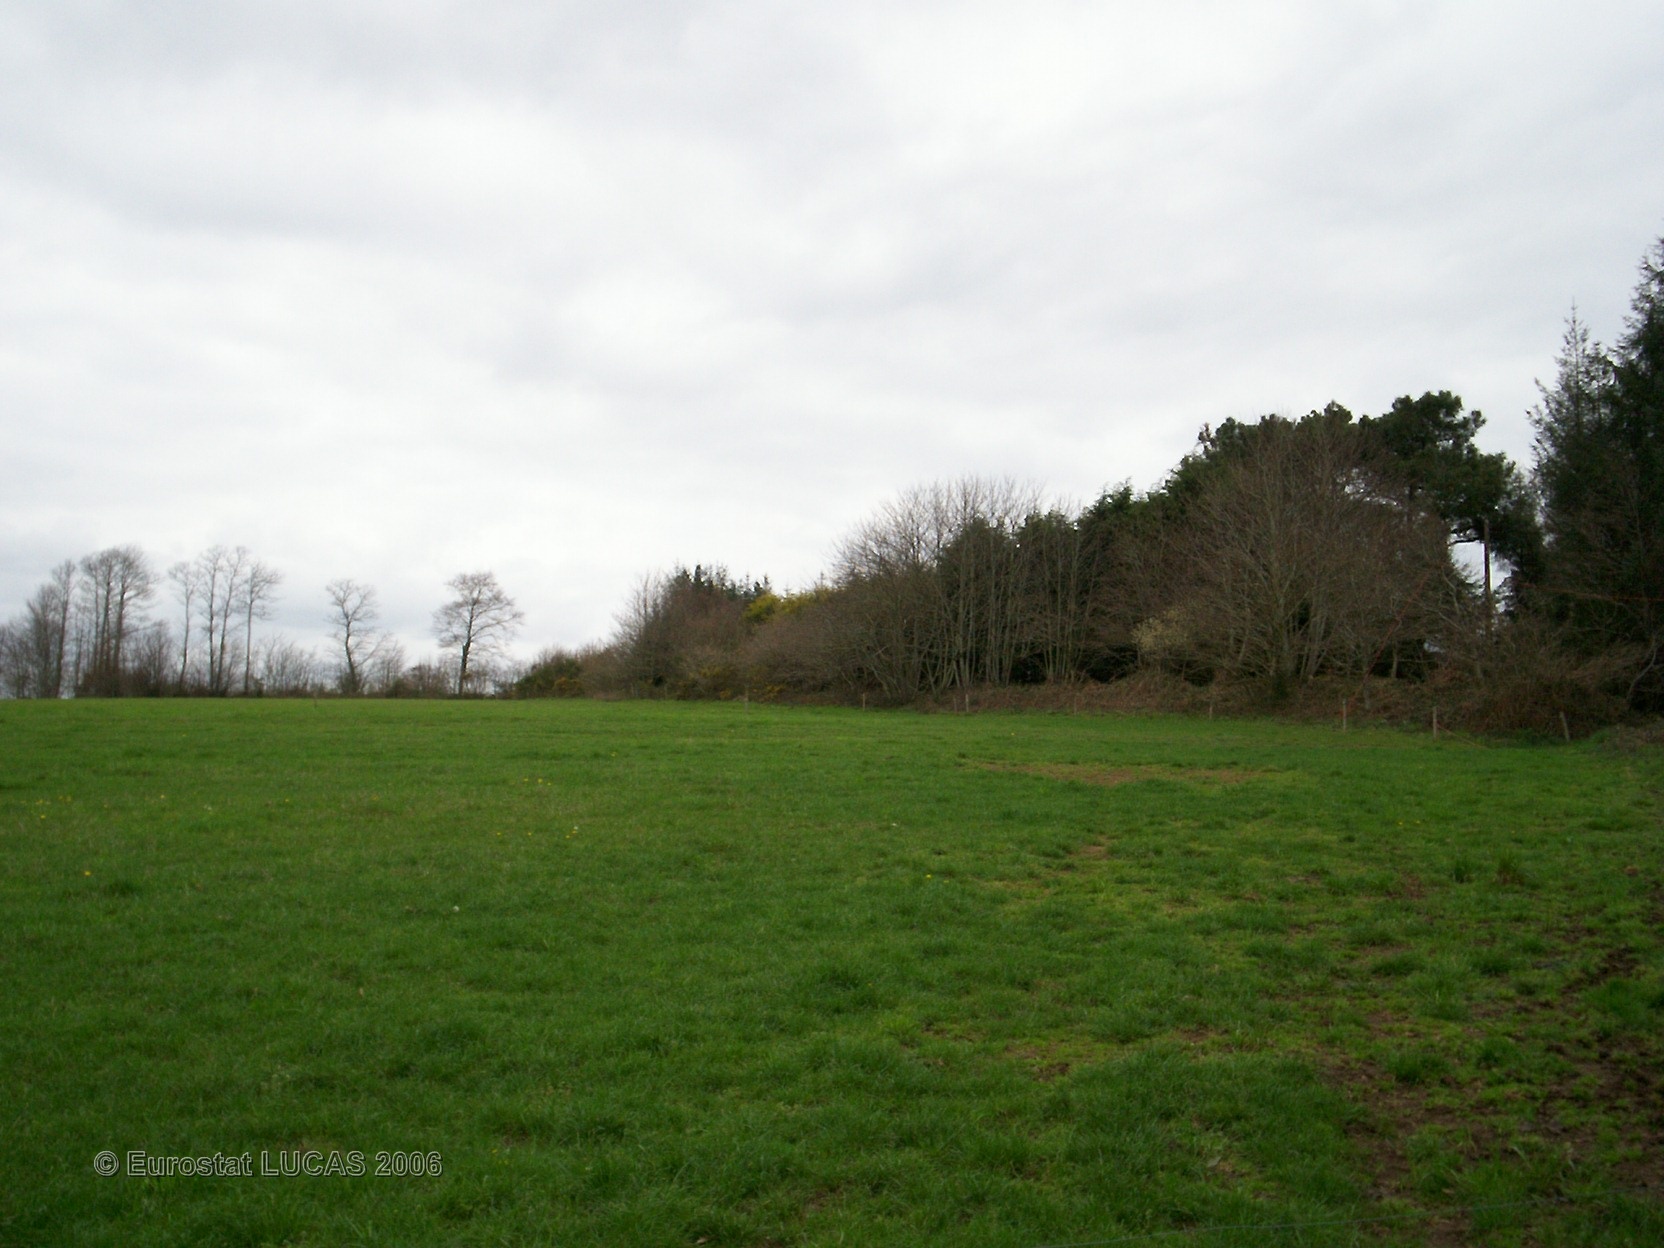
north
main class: Grassland
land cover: Grassland without tree/shrub cover
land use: Agriculture (excluding fallow land and kitchen gardens)
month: April
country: FR
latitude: 47.9530
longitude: -3.5071
